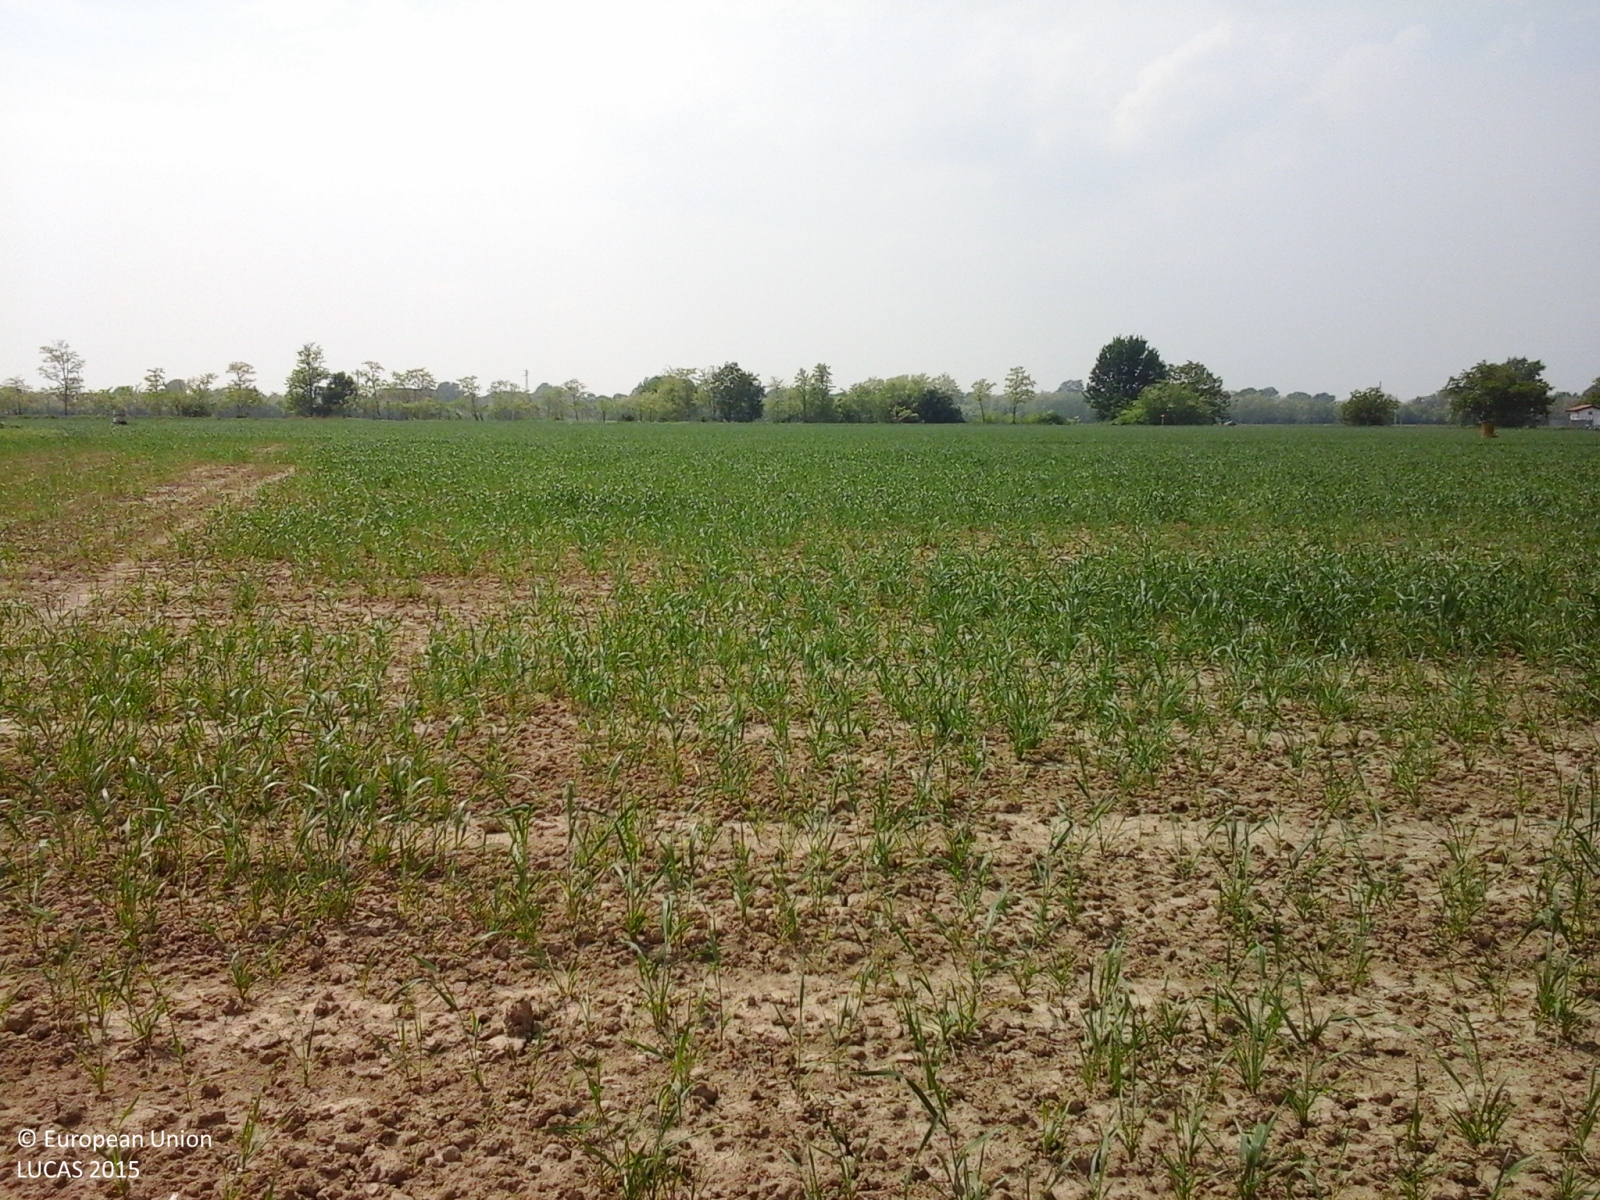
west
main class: Cropland
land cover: Maize
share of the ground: < 10 %
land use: Agriculture (excluding fallow land and kitchen gardens)
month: May
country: IT
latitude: 44.8828
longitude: 8.6480
